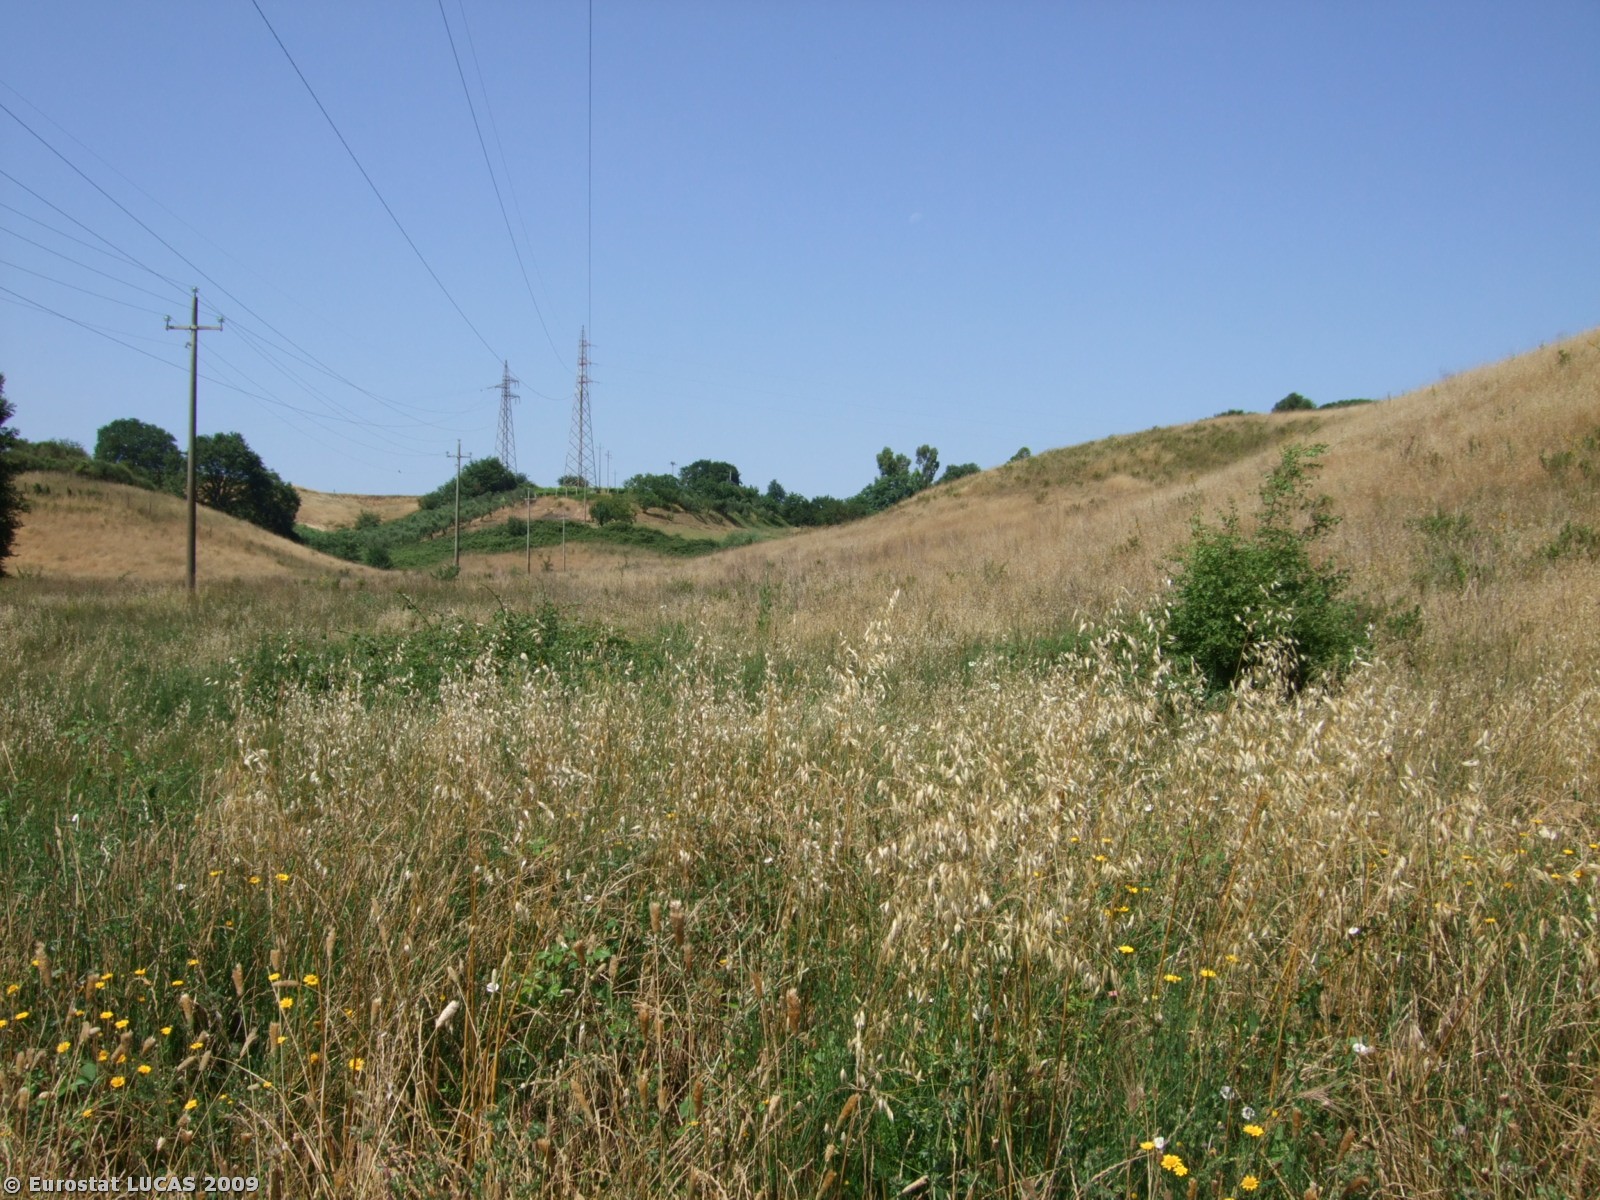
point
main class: Grassland
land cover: Grassland without tree/shrub cover
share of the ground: > 75 %
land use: Fallow land
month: June
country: IT
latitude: 41.8504
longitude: 12.3158
